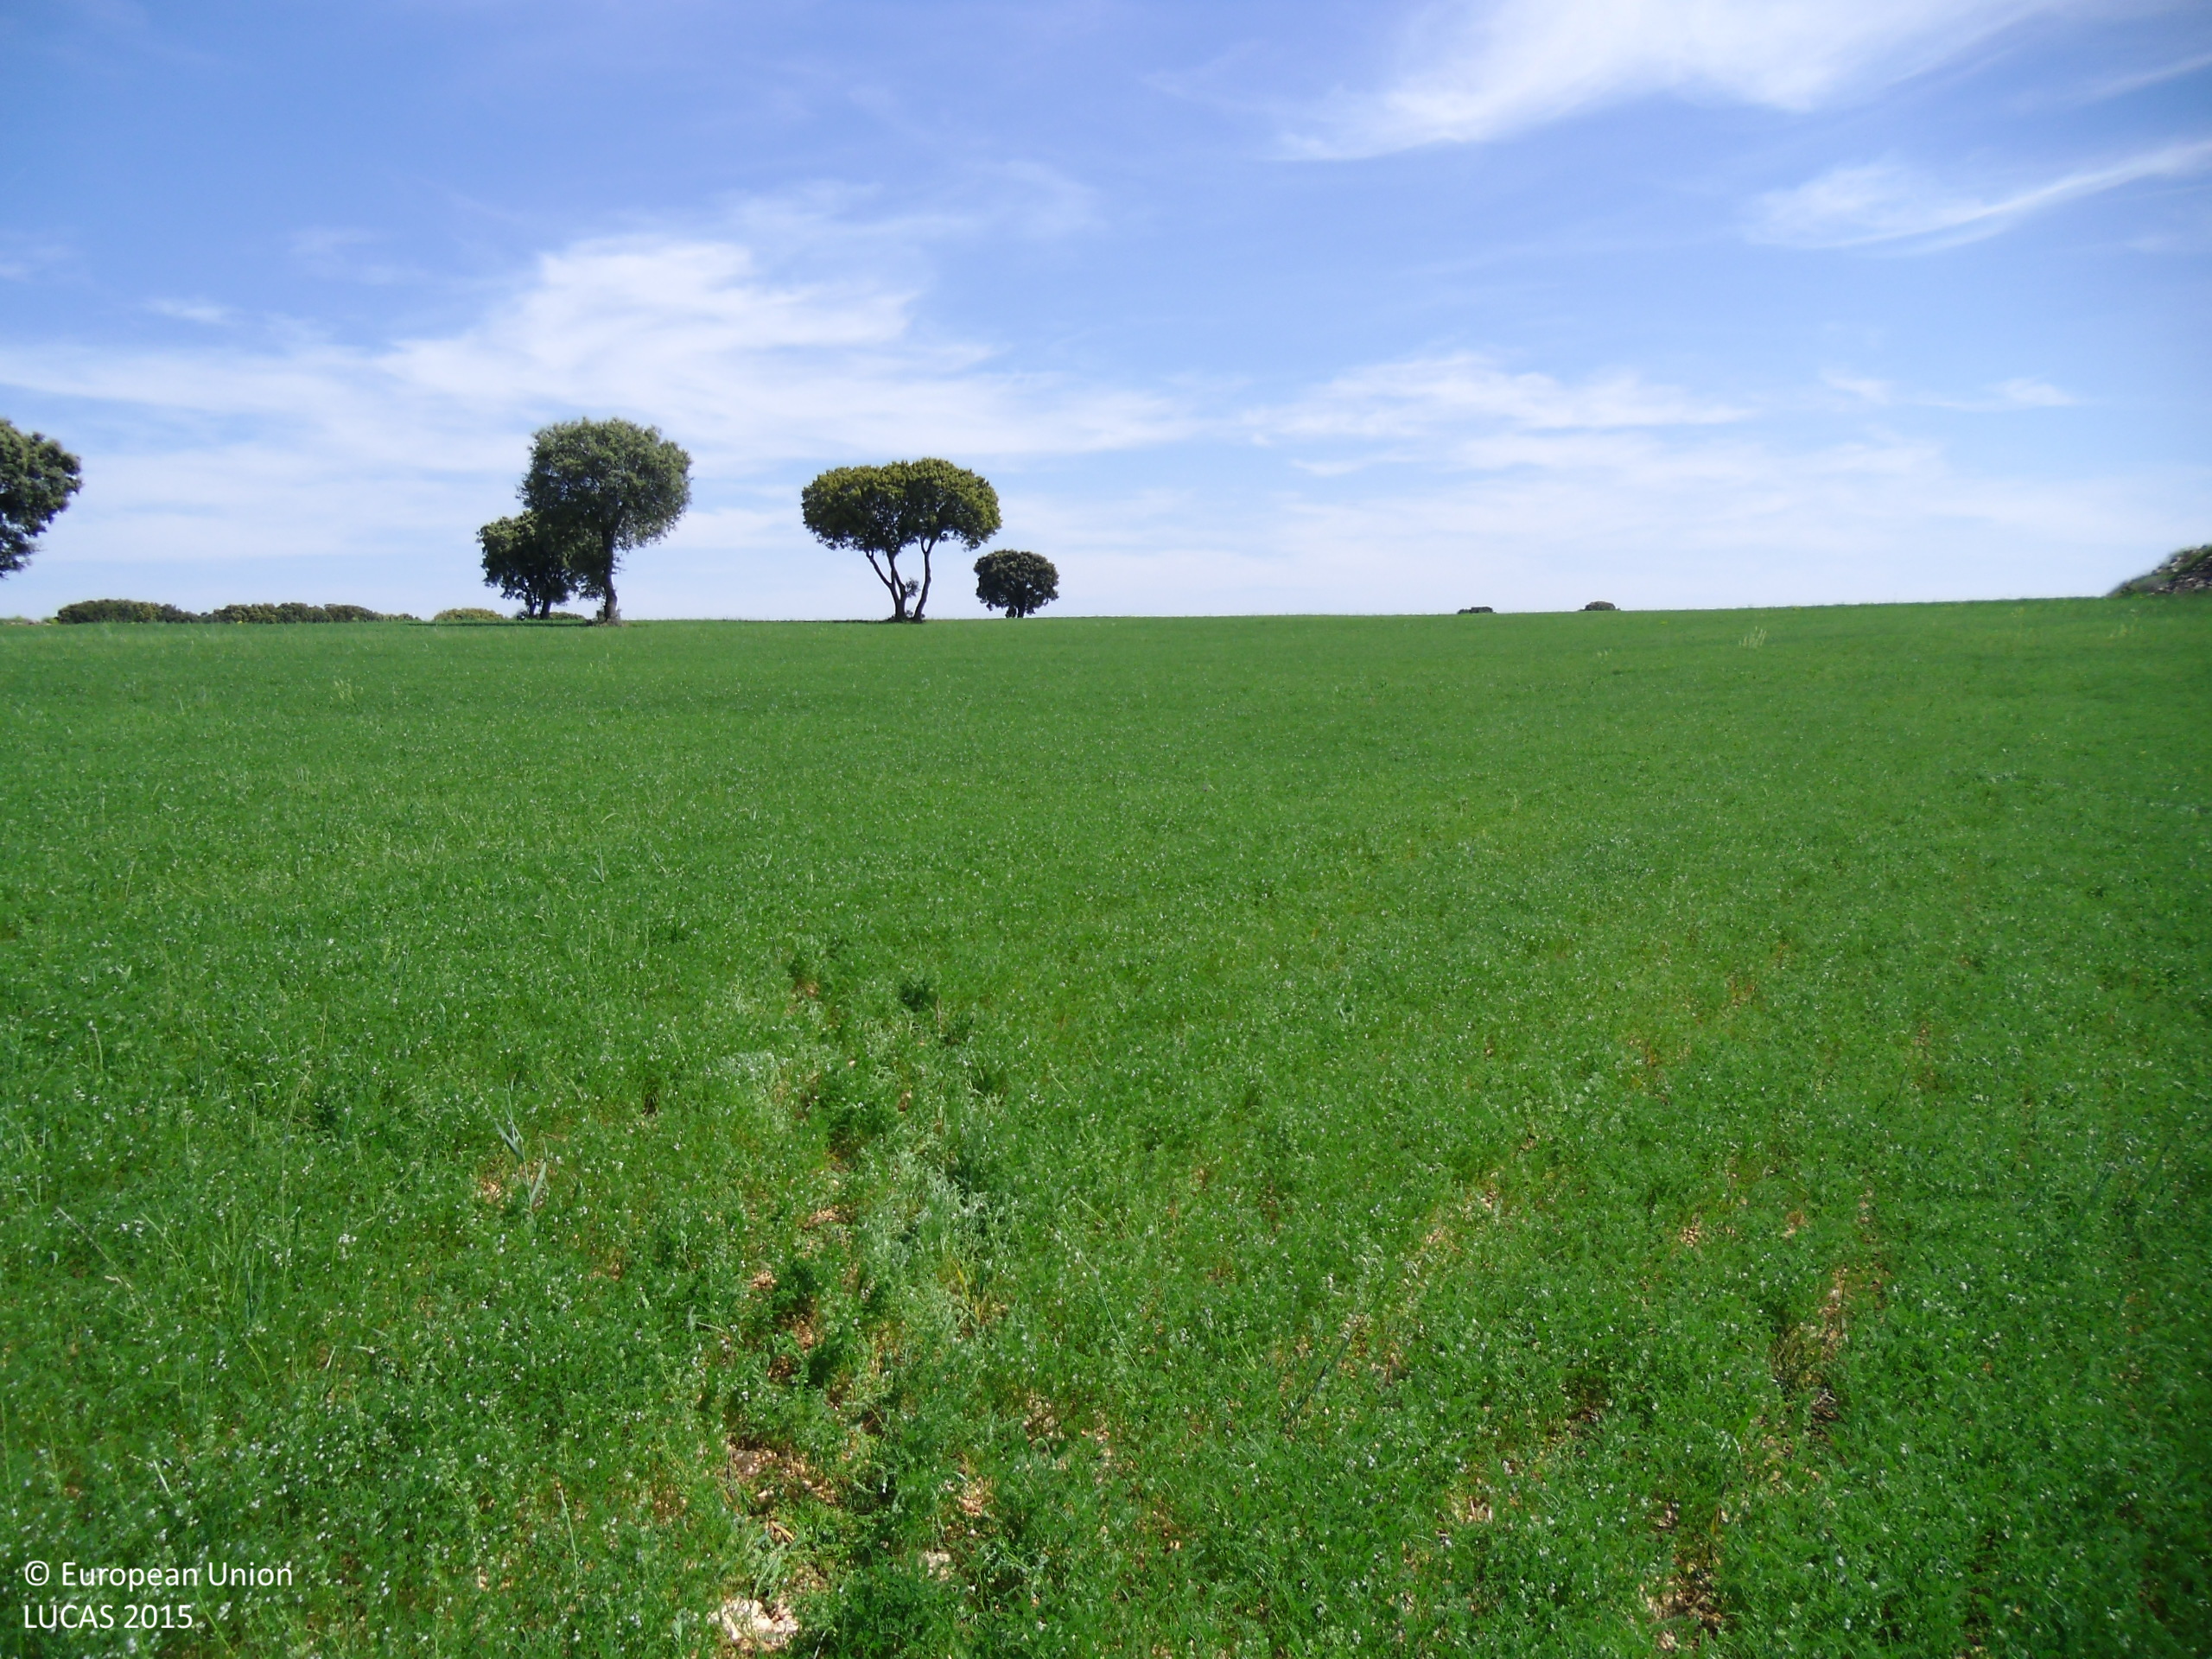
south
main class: Cropland
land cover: Dry pulses
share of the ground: > 75 %
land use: Agriculture (excluding fallow land and kitchen gardens)
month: May
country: ES
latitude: 40.6071
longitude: -2.8526
